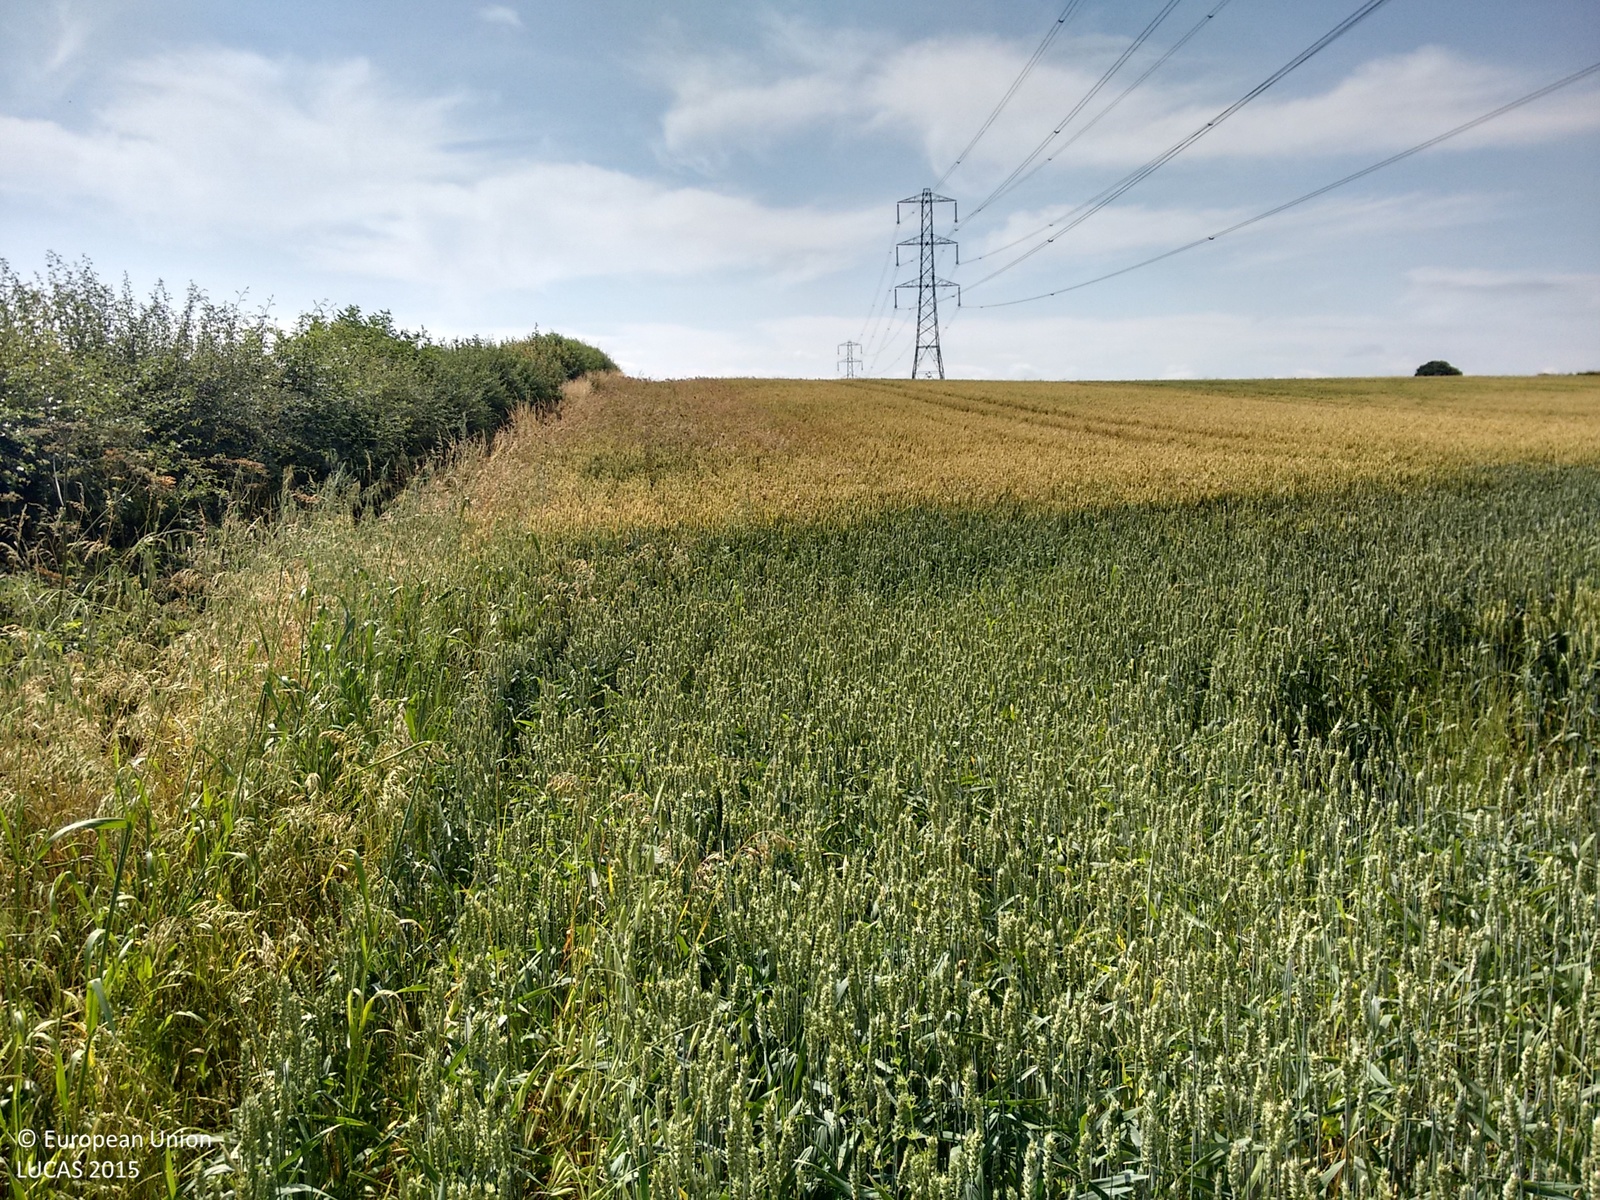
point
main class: Cropland
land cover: Common wheat
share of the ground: > 75 %
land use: Agriculture (excluding fallow land and kitchen gardens)
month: July
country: GB
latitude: 53.1690
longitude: -0.8270
